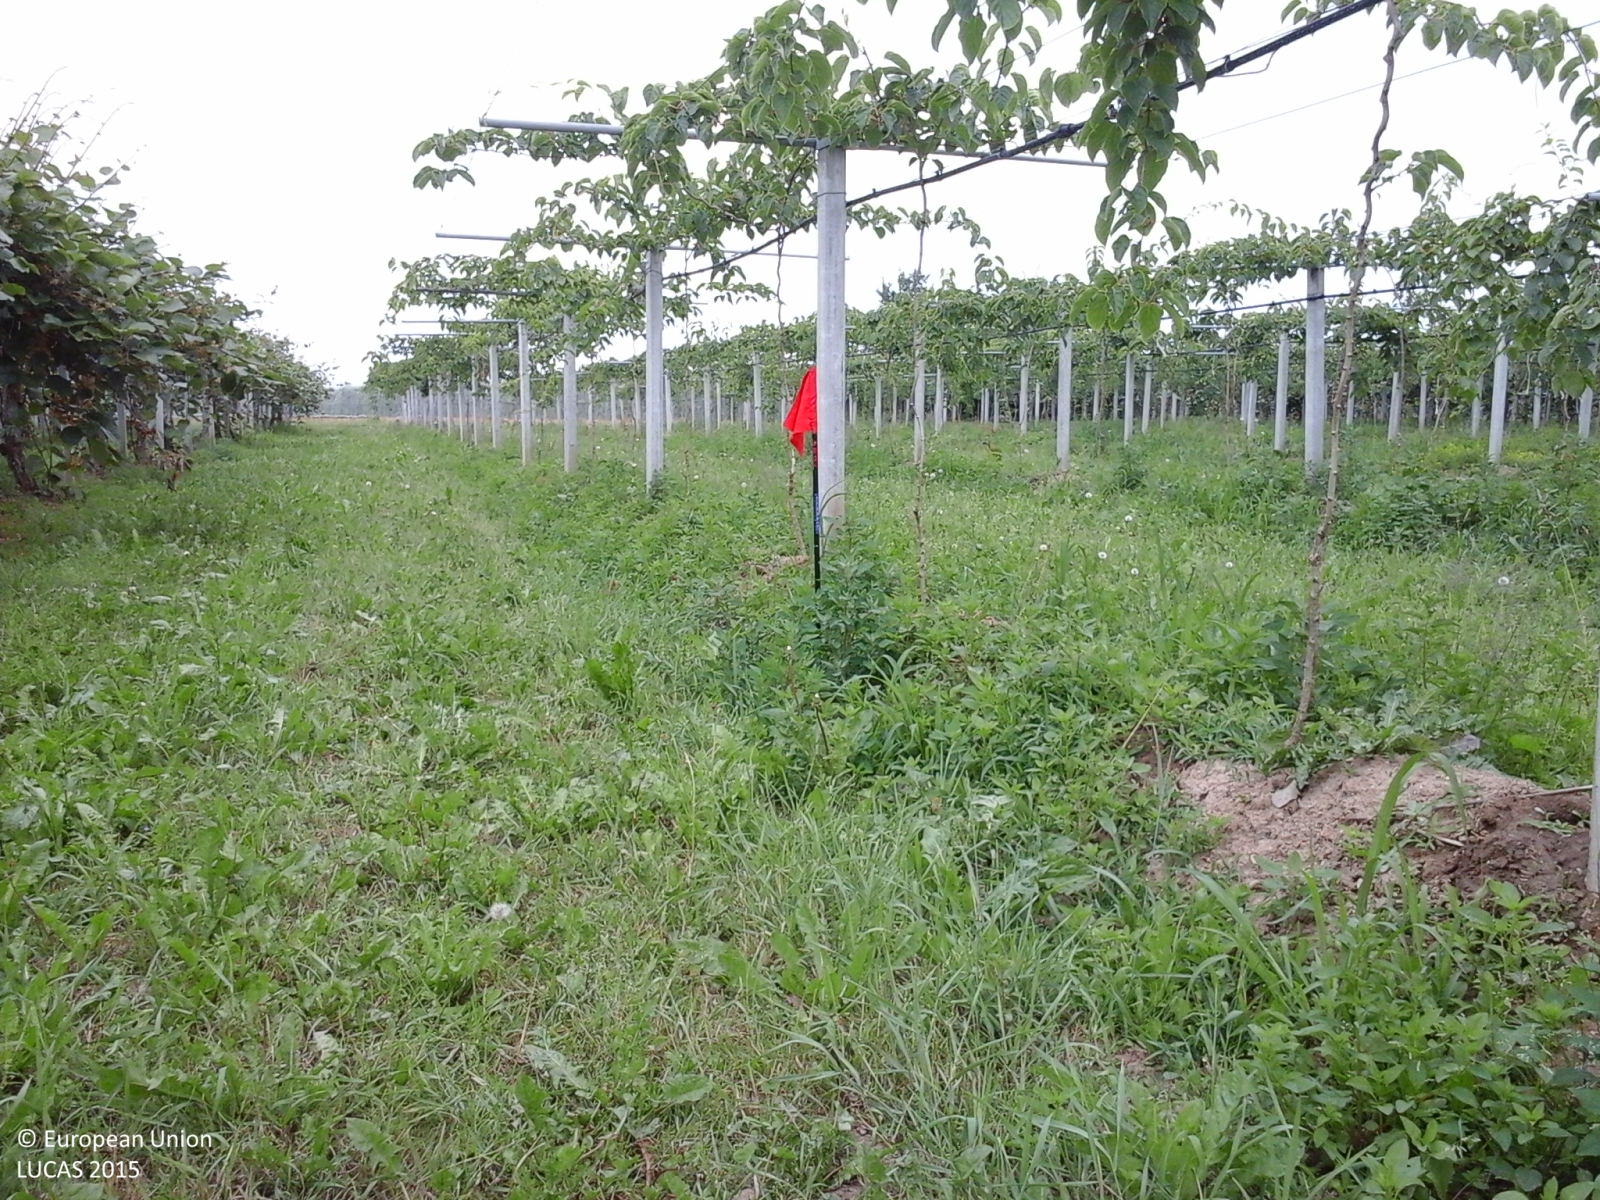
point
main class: Cropland
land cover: Other fruit trees and berries
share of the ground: 10 - 25 %
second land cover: Grassland without tree/shrub cover
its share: > 75 %
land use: Agriculture (excluding fallow land and kitchen gardens)
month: May
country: IT
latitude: 44.6277
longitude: 7.5218
